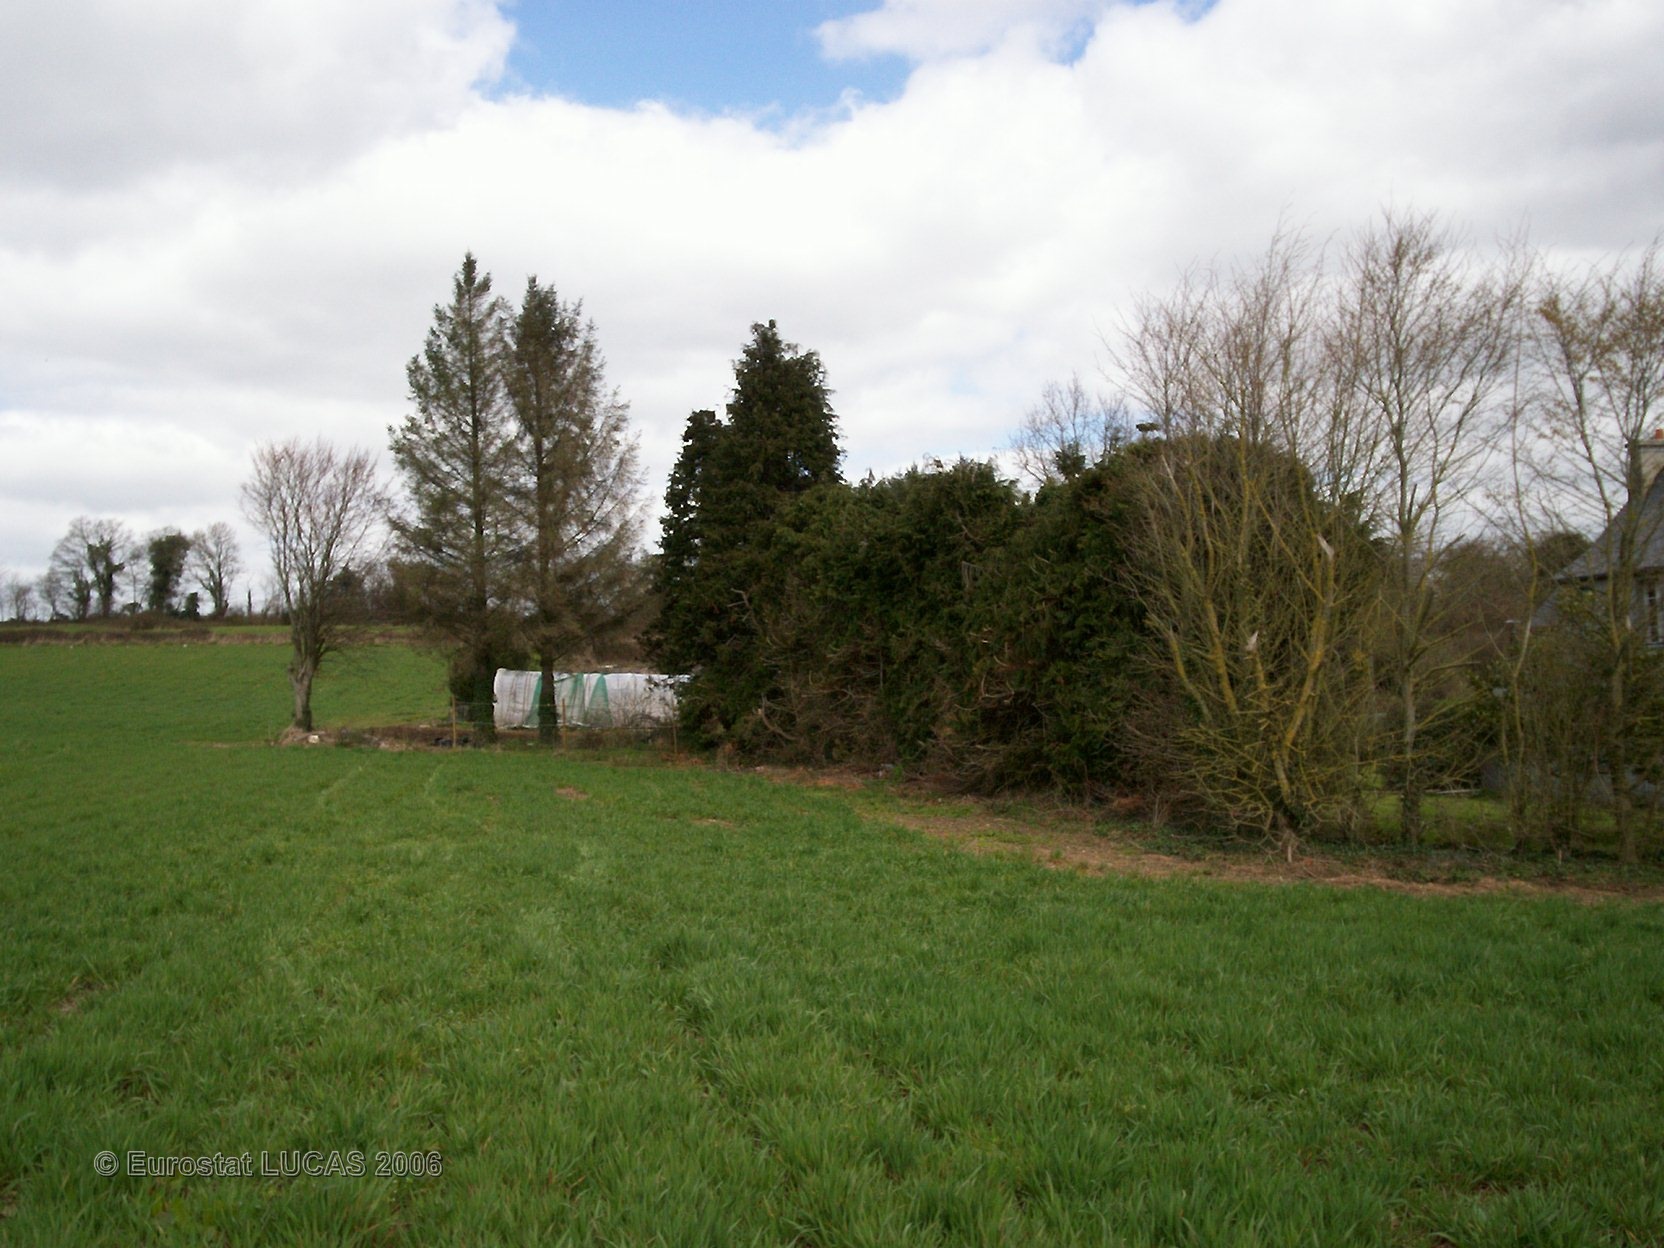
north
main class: Cropland
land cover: Oats
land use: Agriculture (excluding fallow land and kitchen gardens)
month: April
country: FR
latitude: 48.2321
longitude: -3.6101
